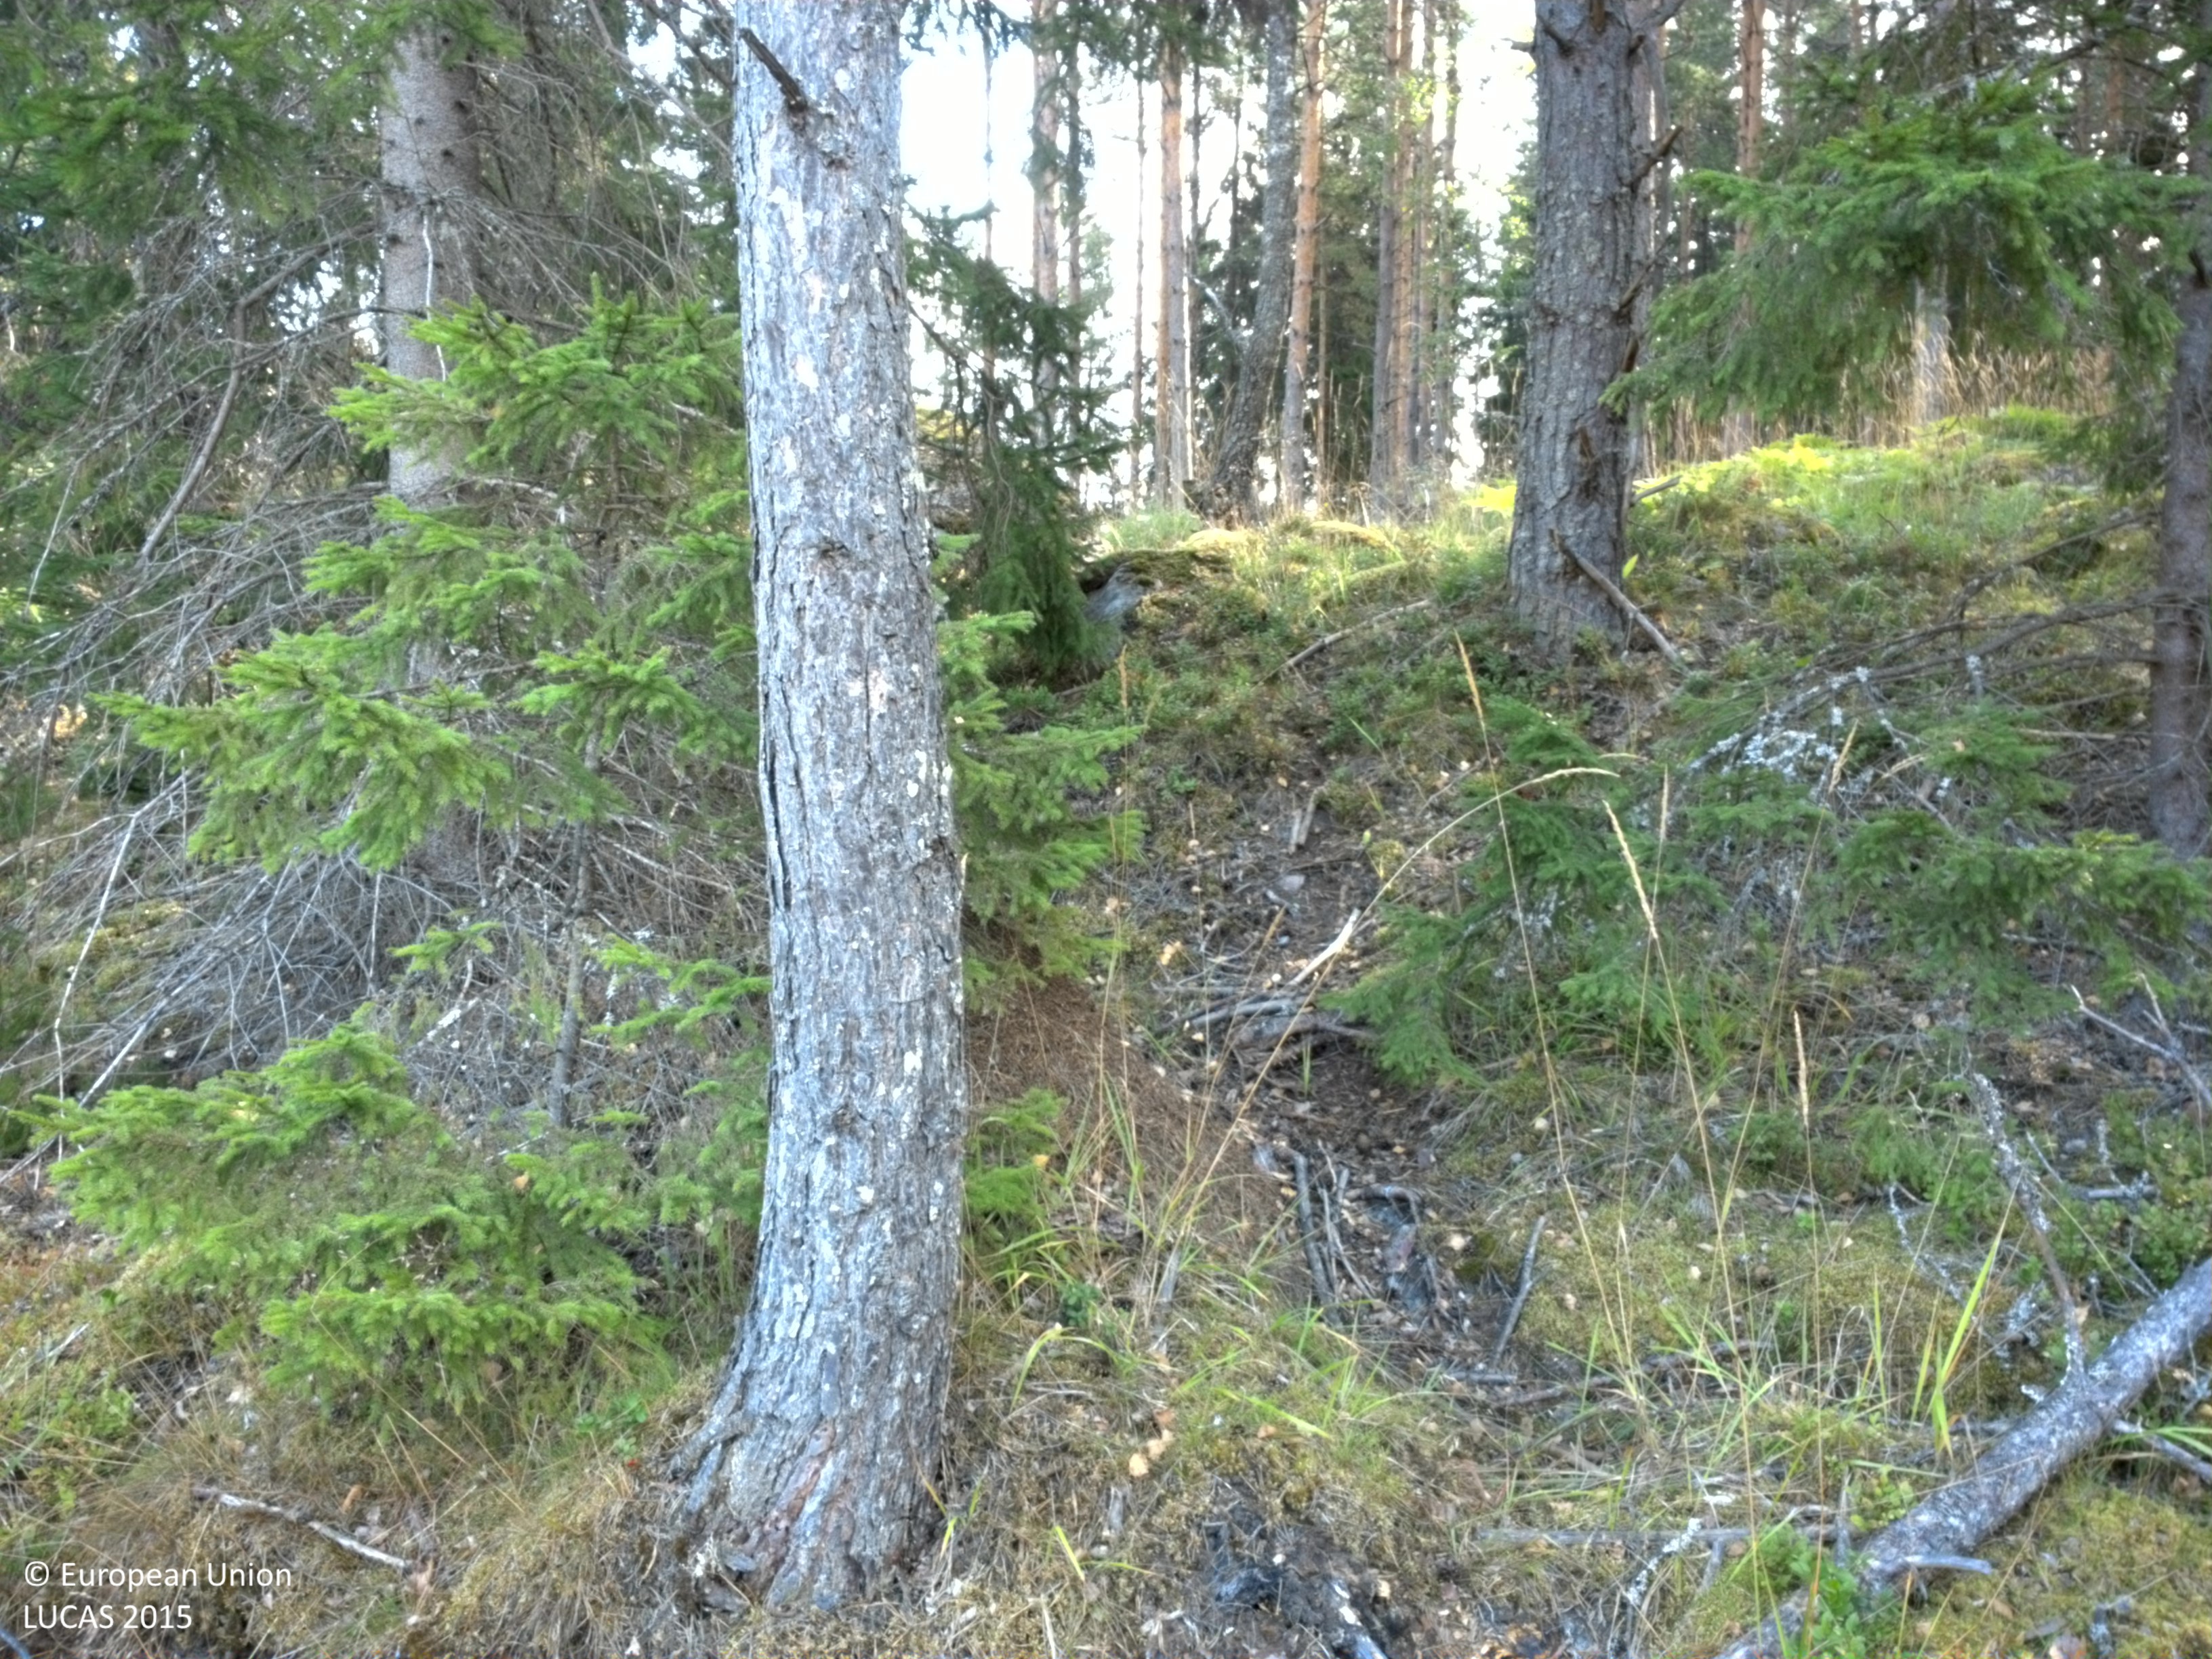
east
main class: Woodland
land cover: Pine dominated coniferous woodland
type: boreal forest
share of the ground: 50 - 75 %
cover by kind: coniferous forest trees 65 %, herbaceous plants 15 %, lichens and mosses 15 %, broadleaved forest trees 5 %
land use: Forestry
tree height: > 5 m
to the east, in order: Pine dominated coniferous woodland; Spruce dominated coniferous woodland; Grassland without tree/shrub cover; Ditches and canals; Spruce dominated coniferous woodland
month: August
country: SE
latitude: 59.5781
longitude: 17.5910
